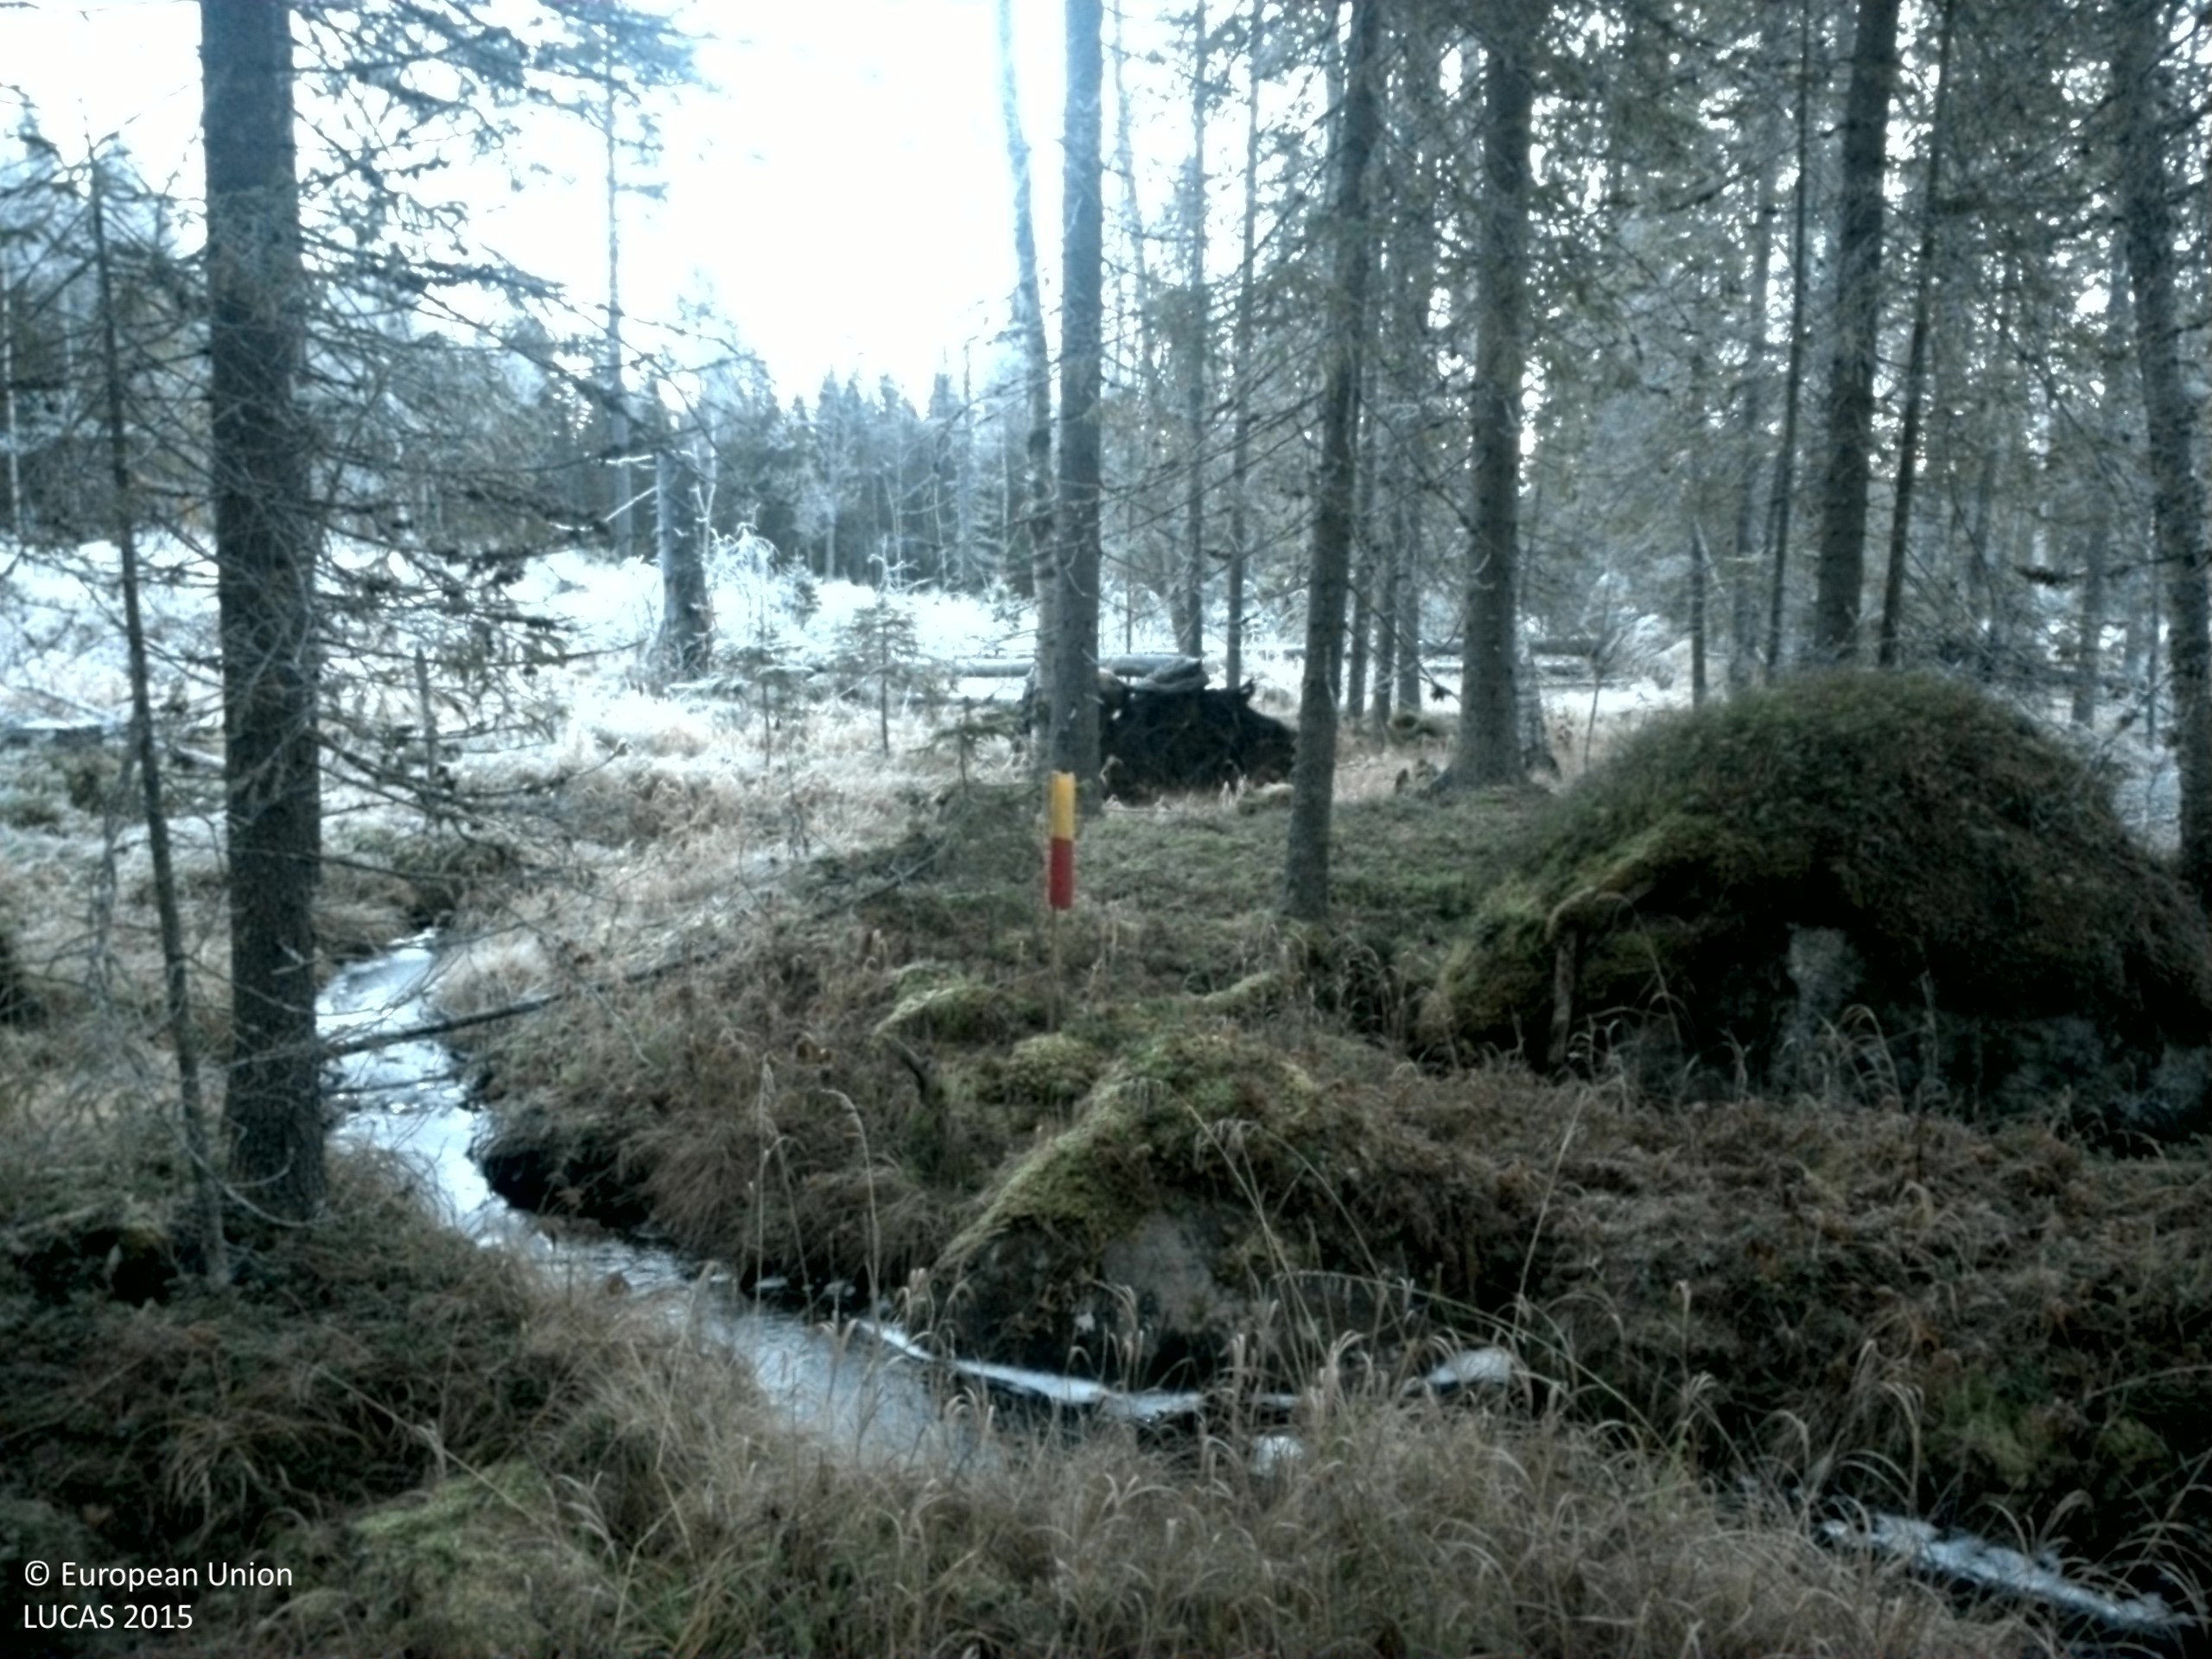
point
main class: Woodland
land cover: Spruce dominated coniferous woodland
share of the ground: 25 - 50 %
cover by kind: herbaceous plants 35 %, coniferous forest trees 20 %, lichens and mosses 20 %, shrubs 15 %, broadleaved forest trees 5 %
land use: Forestry
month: November
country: SE
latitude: 63.7823
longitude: 15.8769
